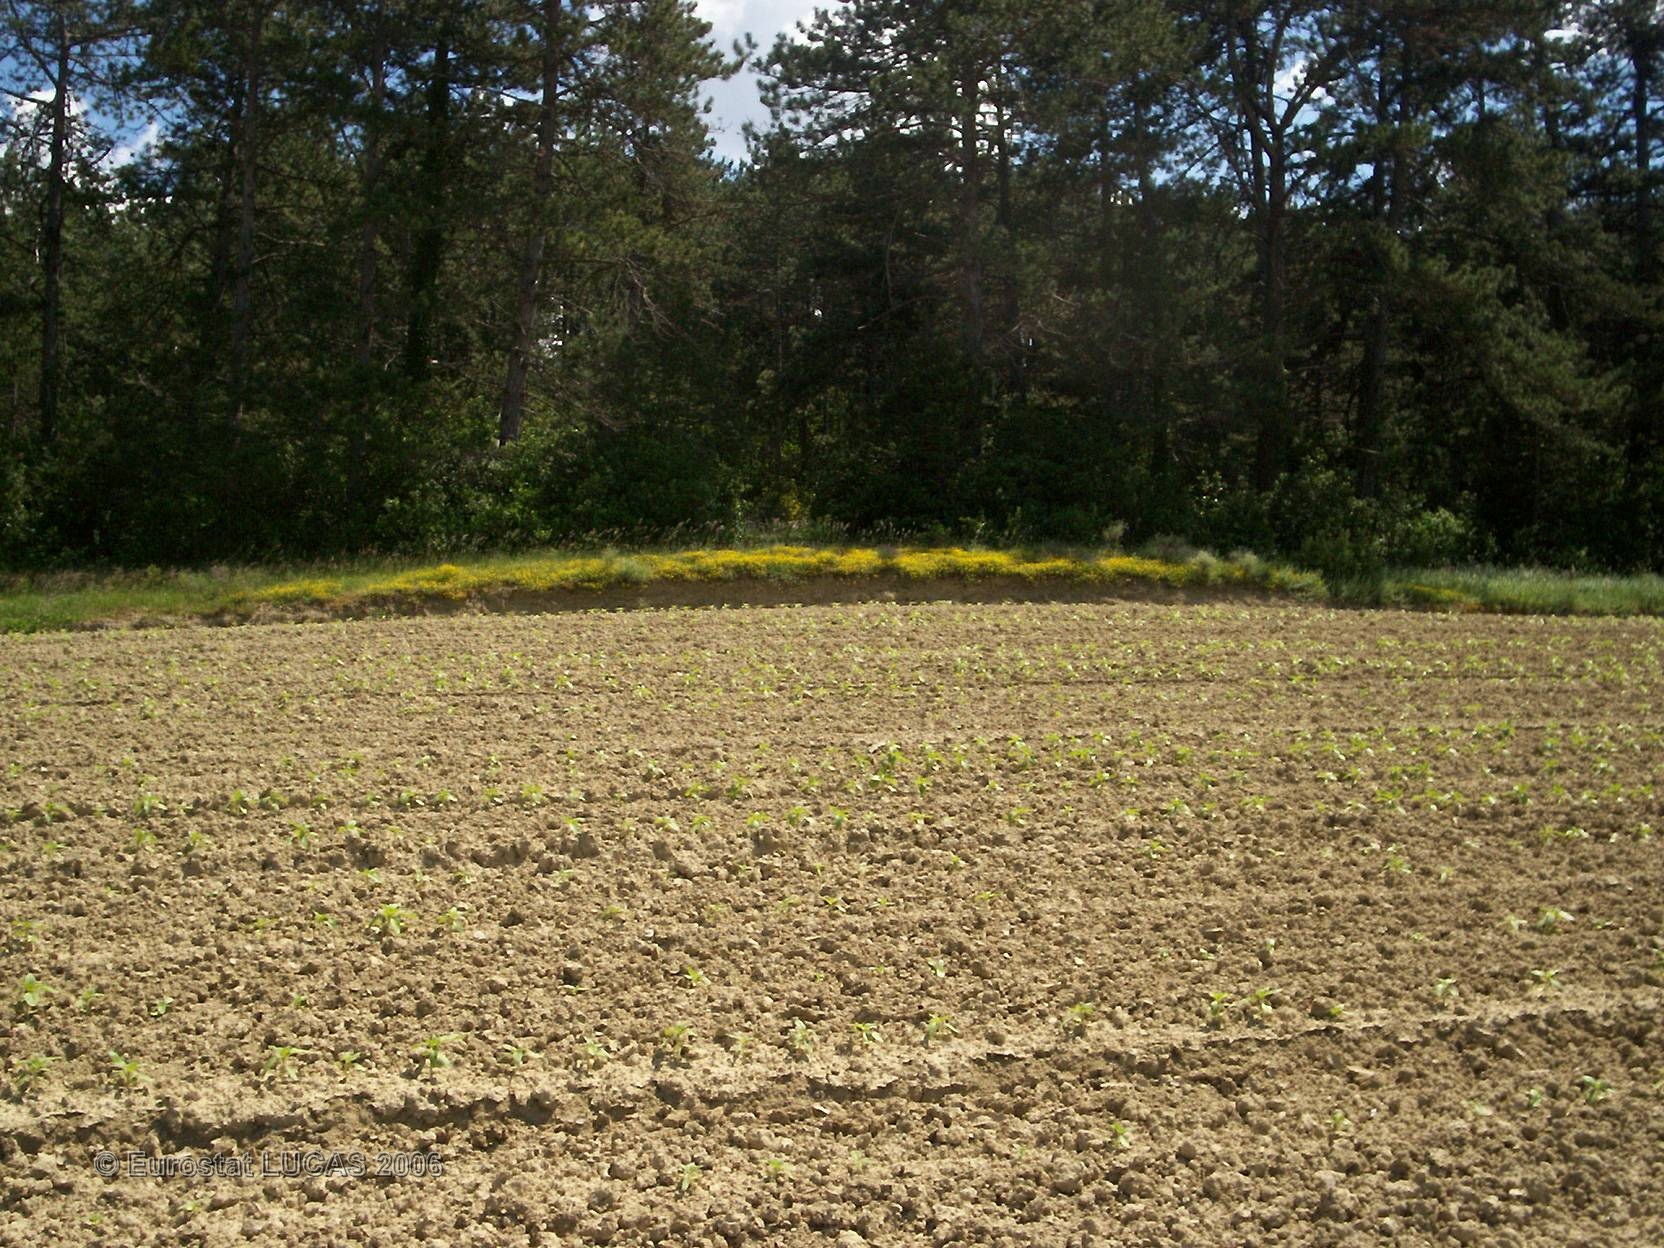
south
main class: Cropland
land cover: Sunflower
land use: Agriculture (excluding fallow land and kitchen gardens)
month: May
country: FR
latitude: 44.5483
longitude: 4.8585
